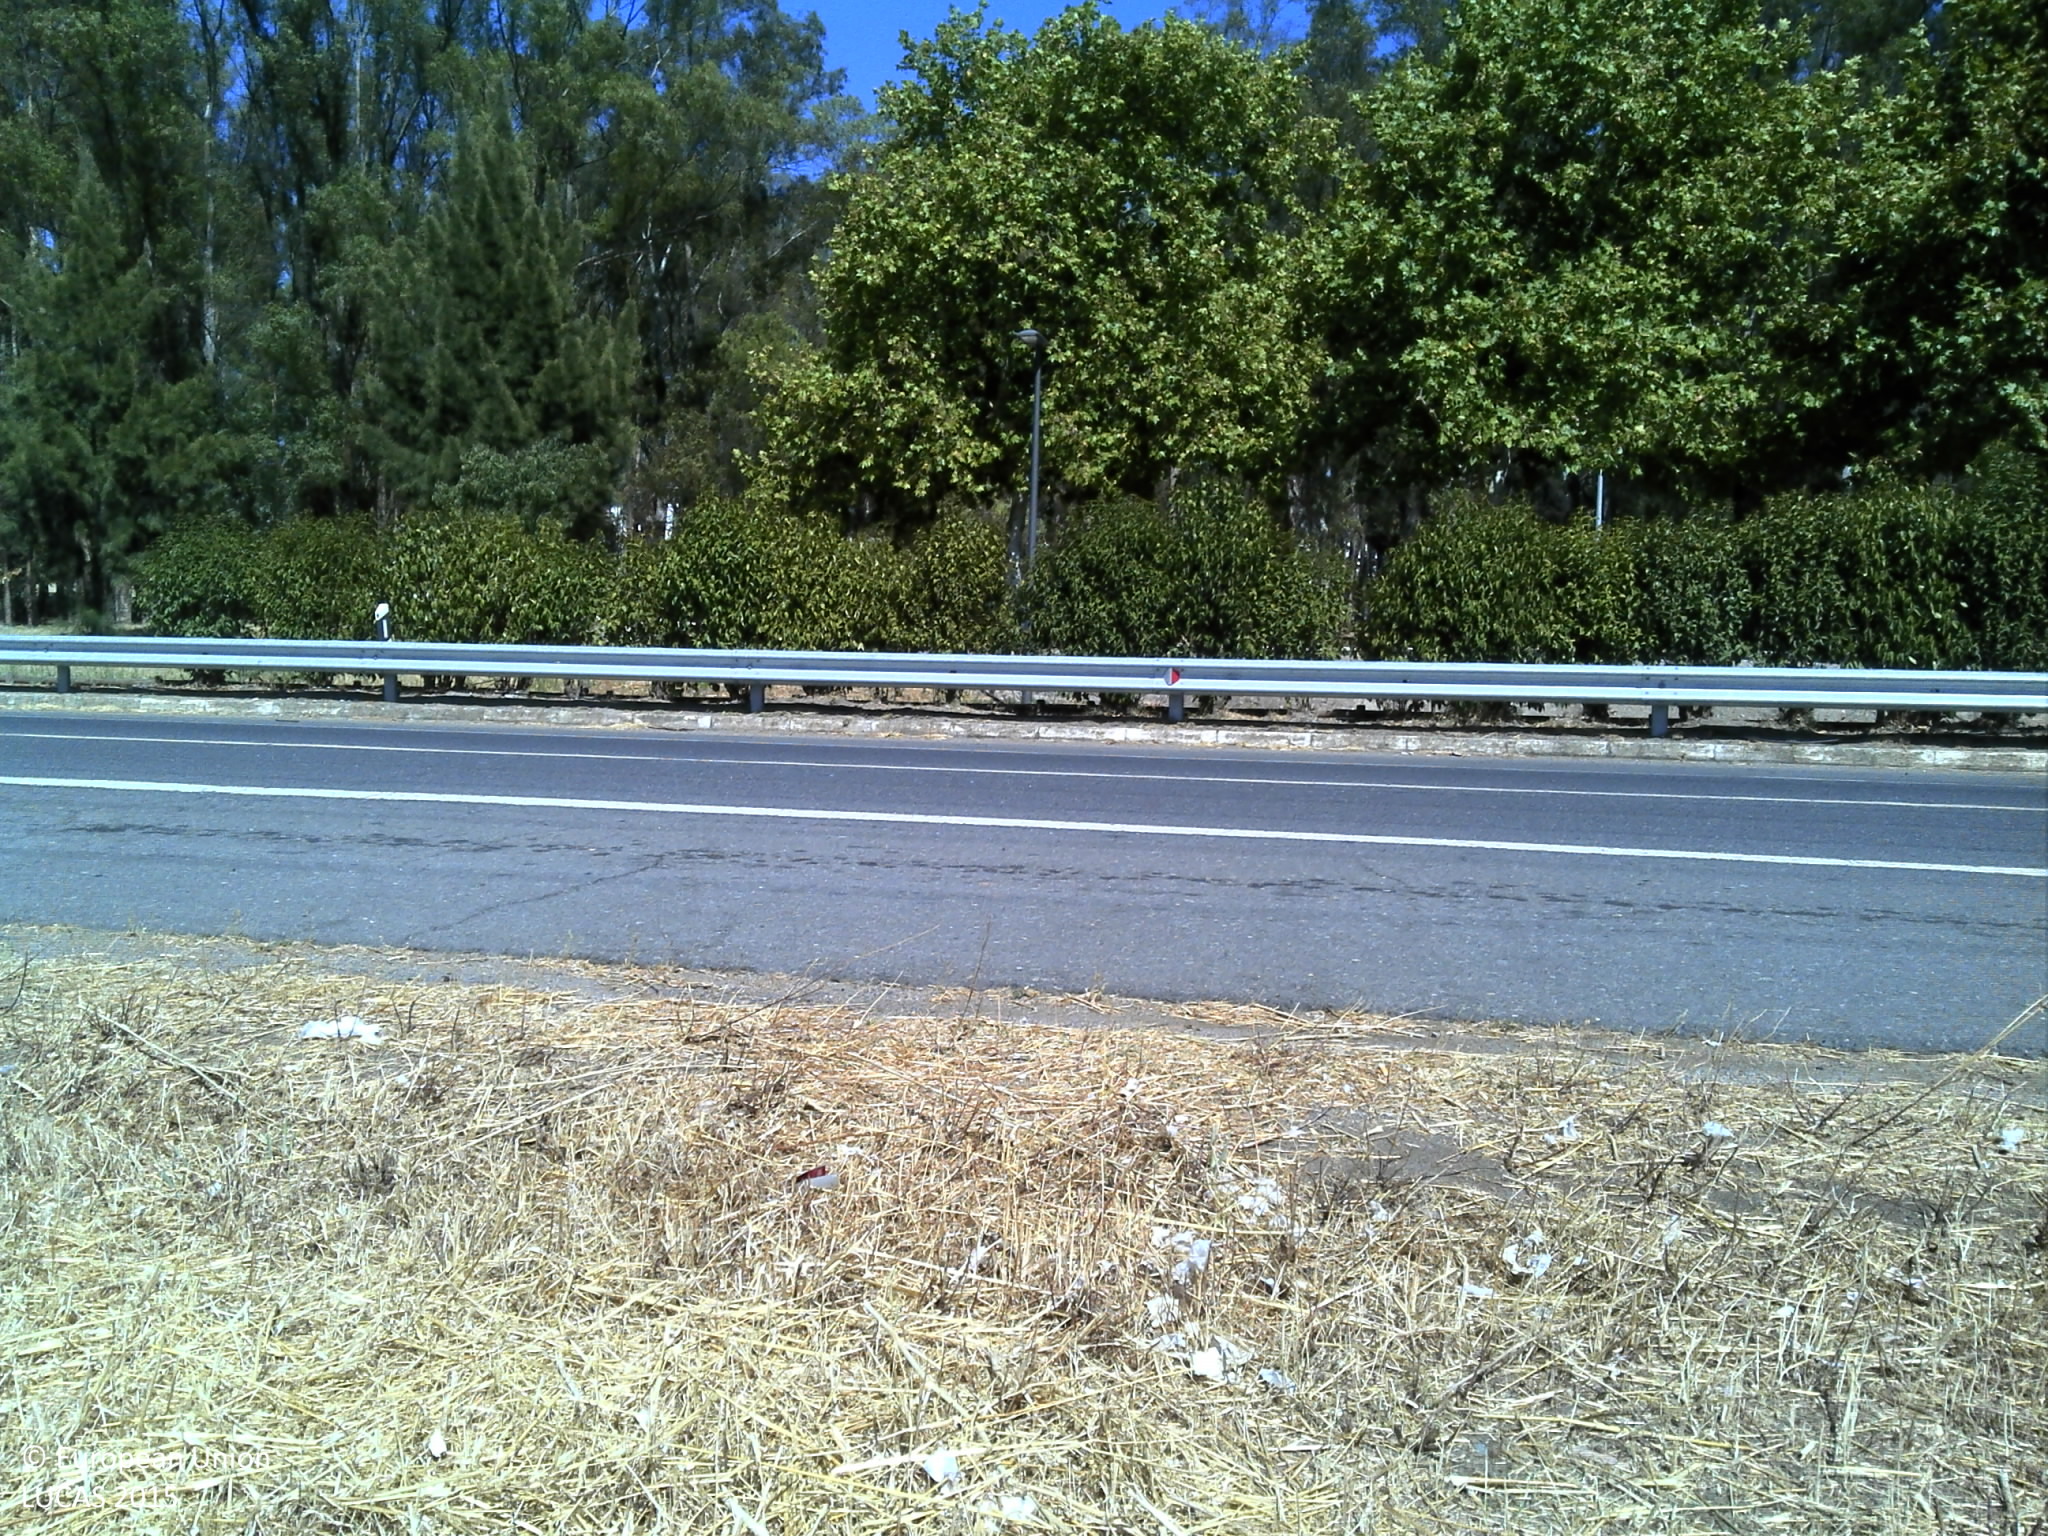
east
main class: Cropland
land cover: Other fruit trees and berries
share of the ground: 50 - 75 %
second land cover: Other bare soil
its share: > 75 %
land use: Agriculture (excluding fallow land and kitchen gardens)
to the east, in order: Other fruit trees and berries; Other bare soil; Electric lines; Fences; Grass margins; Paved roads, cycling and walking lanes; Abandoned hedges; Paved roads, cycling and walking lanes; Ditches and canals; Grassland with sparse tree/shrub cover; Other bare soil; Ditches and canals; Broadleaved woodland; Tracks; Other bare soil; Artificial constructions in urban areas
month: August
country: PT
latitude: 38.0186
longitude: -7.8775
